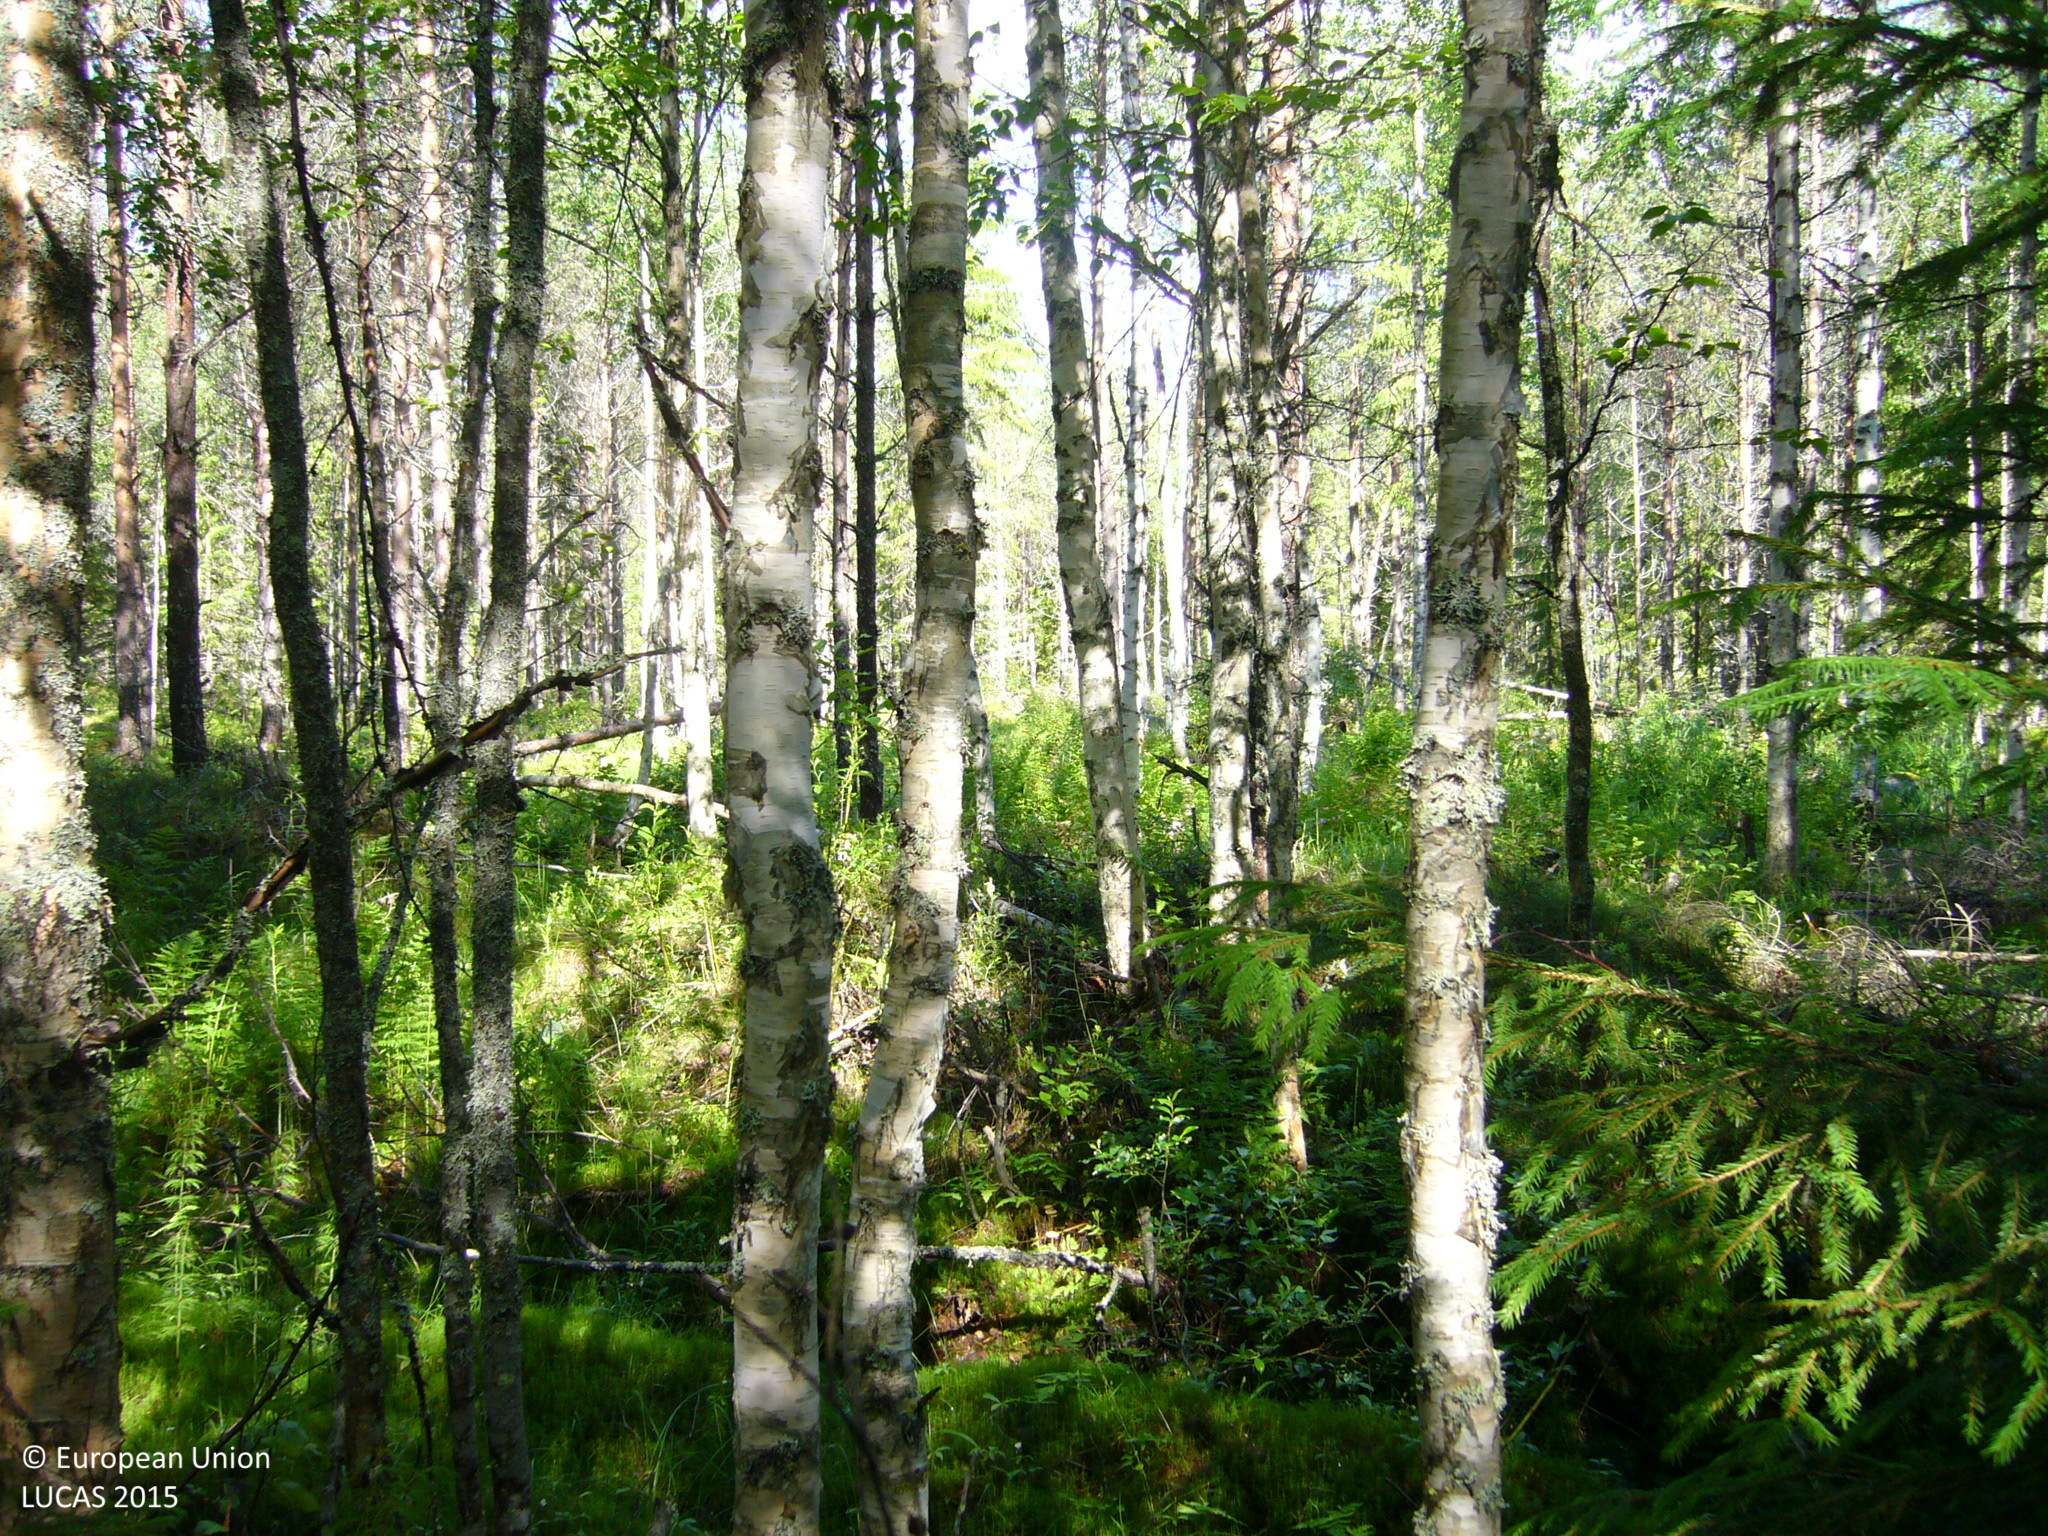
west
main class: Woodland
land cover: Other mixed woodland
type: boreal forest
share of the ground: > 75 %
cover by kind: broadleaved forest trees 50 %, coniferous forest trees 40 %, shrubs 10 %
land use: Forestry
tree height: > 5 m
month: July
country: FI
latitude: 63.6054
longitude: 26.2691
